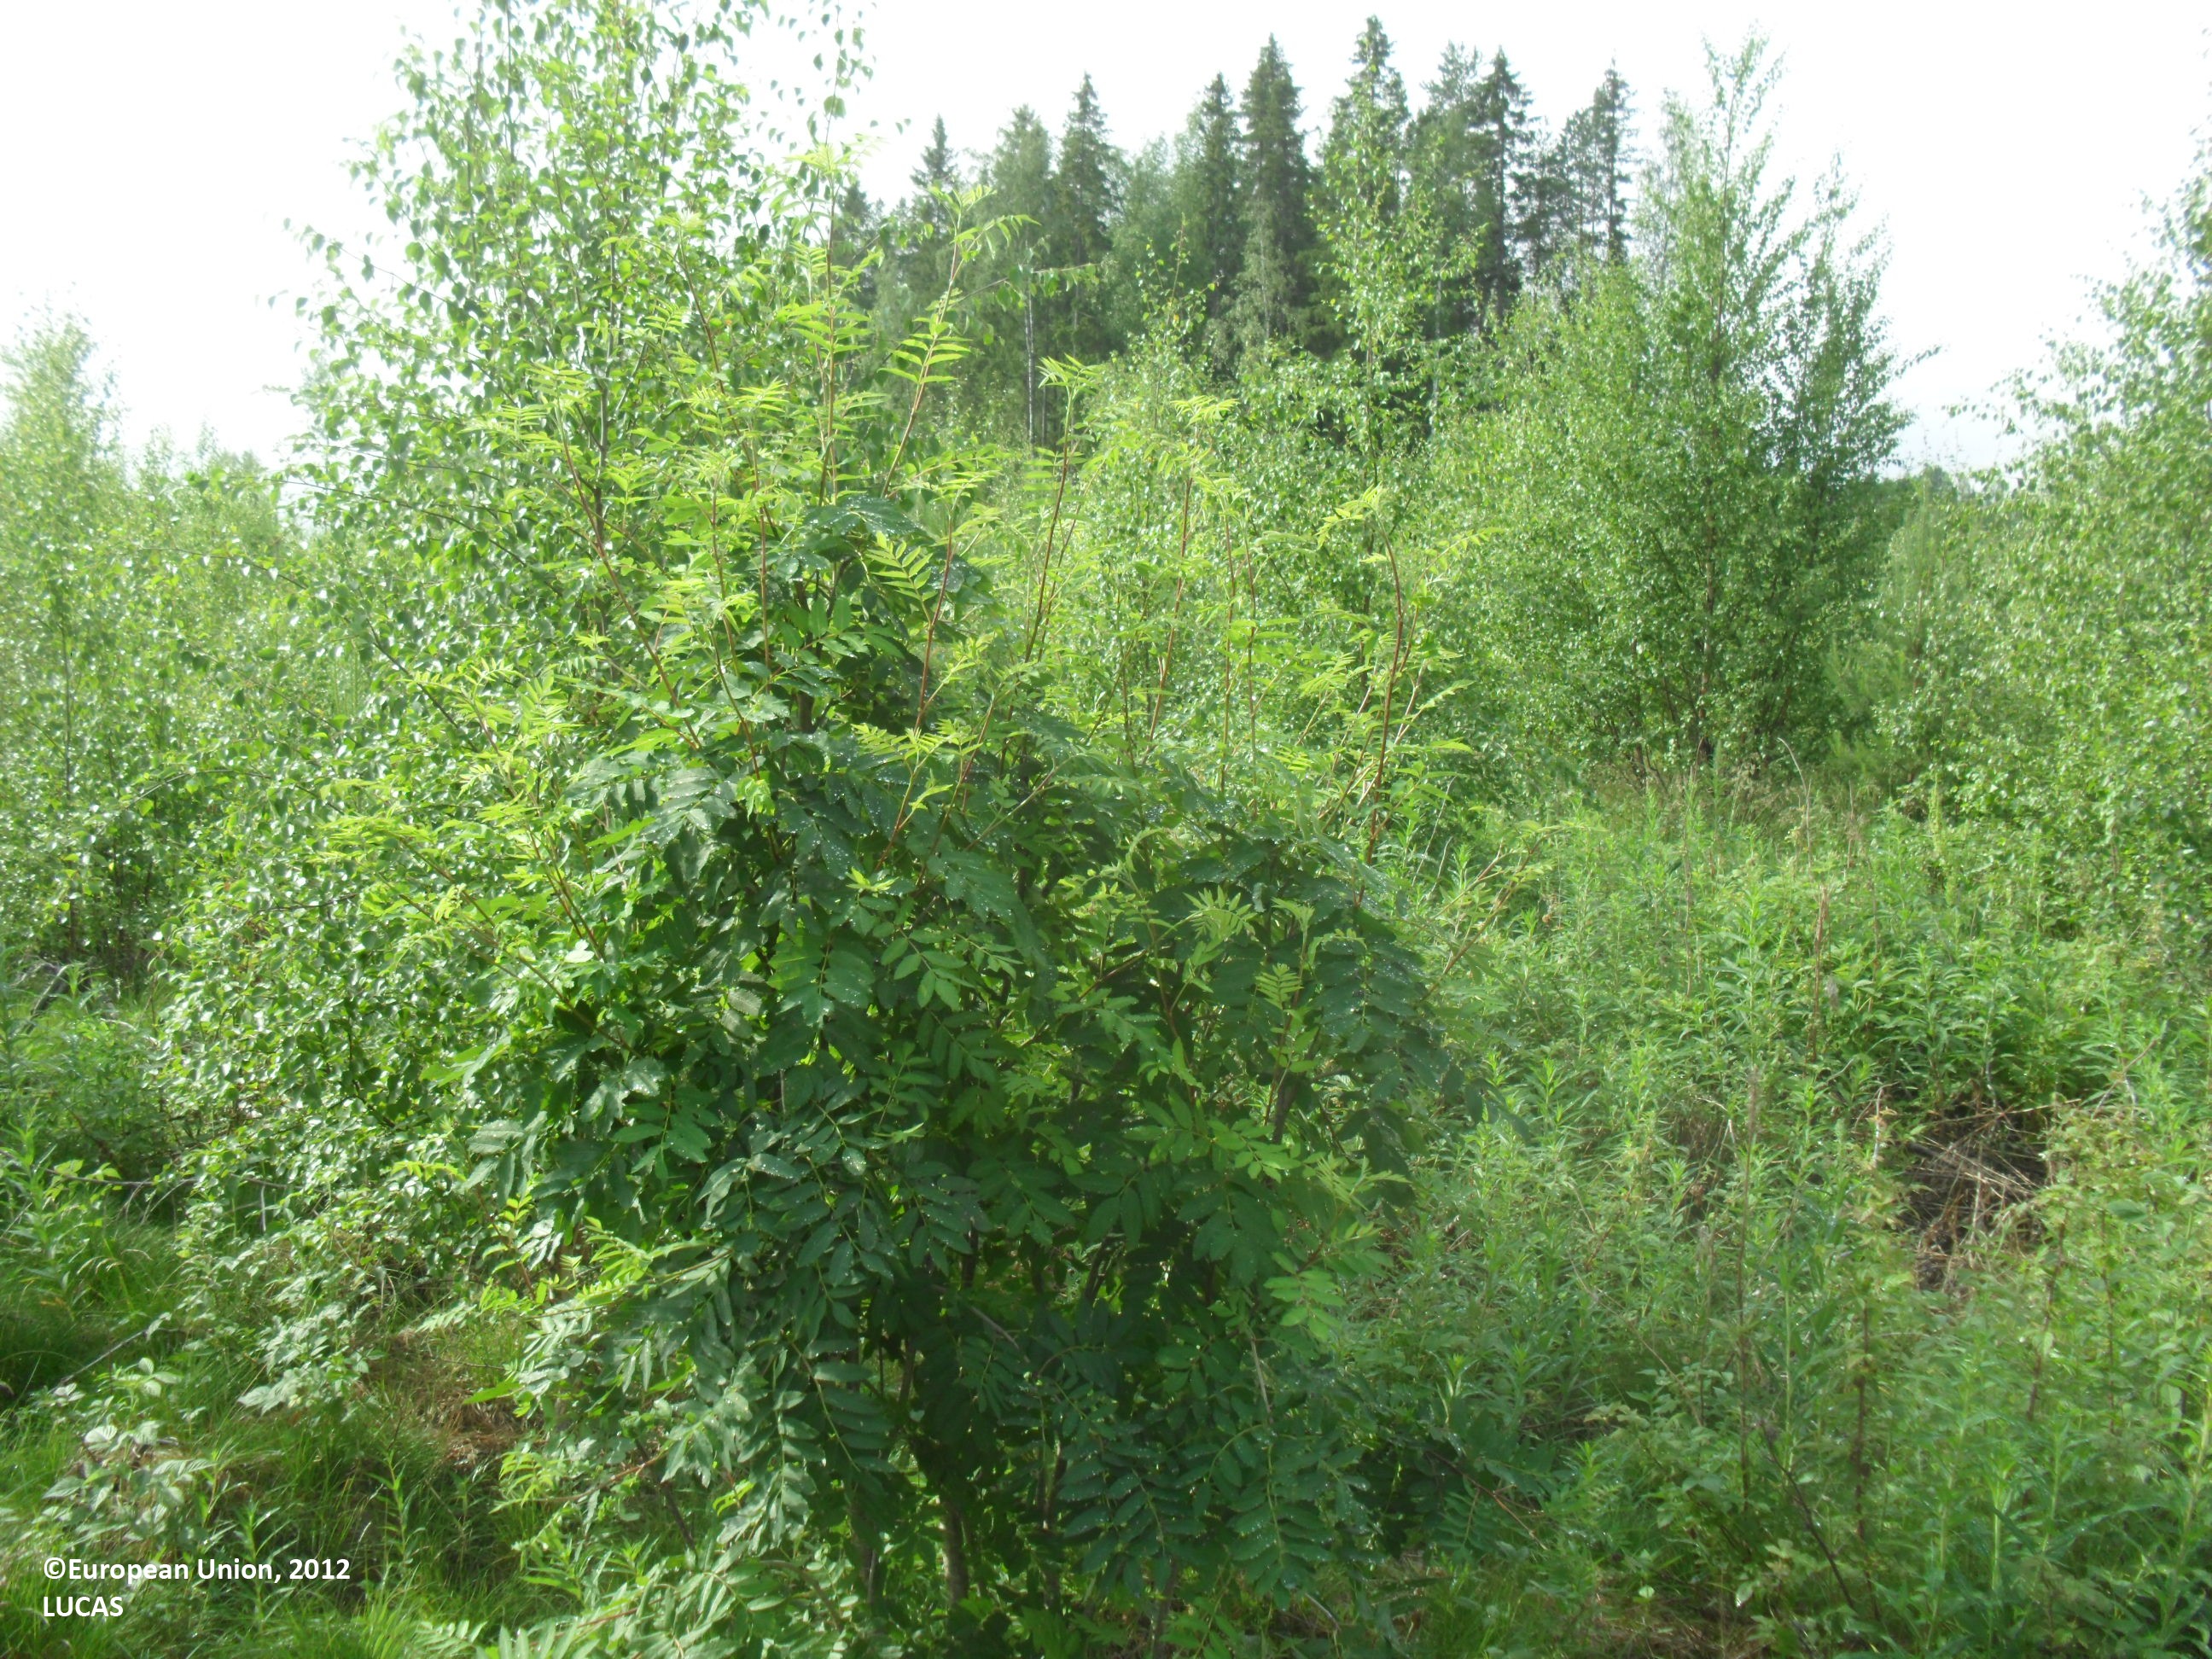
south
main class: Woodland
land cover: Other mixed woodland
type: boreal forest
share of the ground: 10 - 25 %
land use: Forestry
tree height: < 5 m
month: July
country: FI
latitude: 63.4245
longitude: 23.5877
